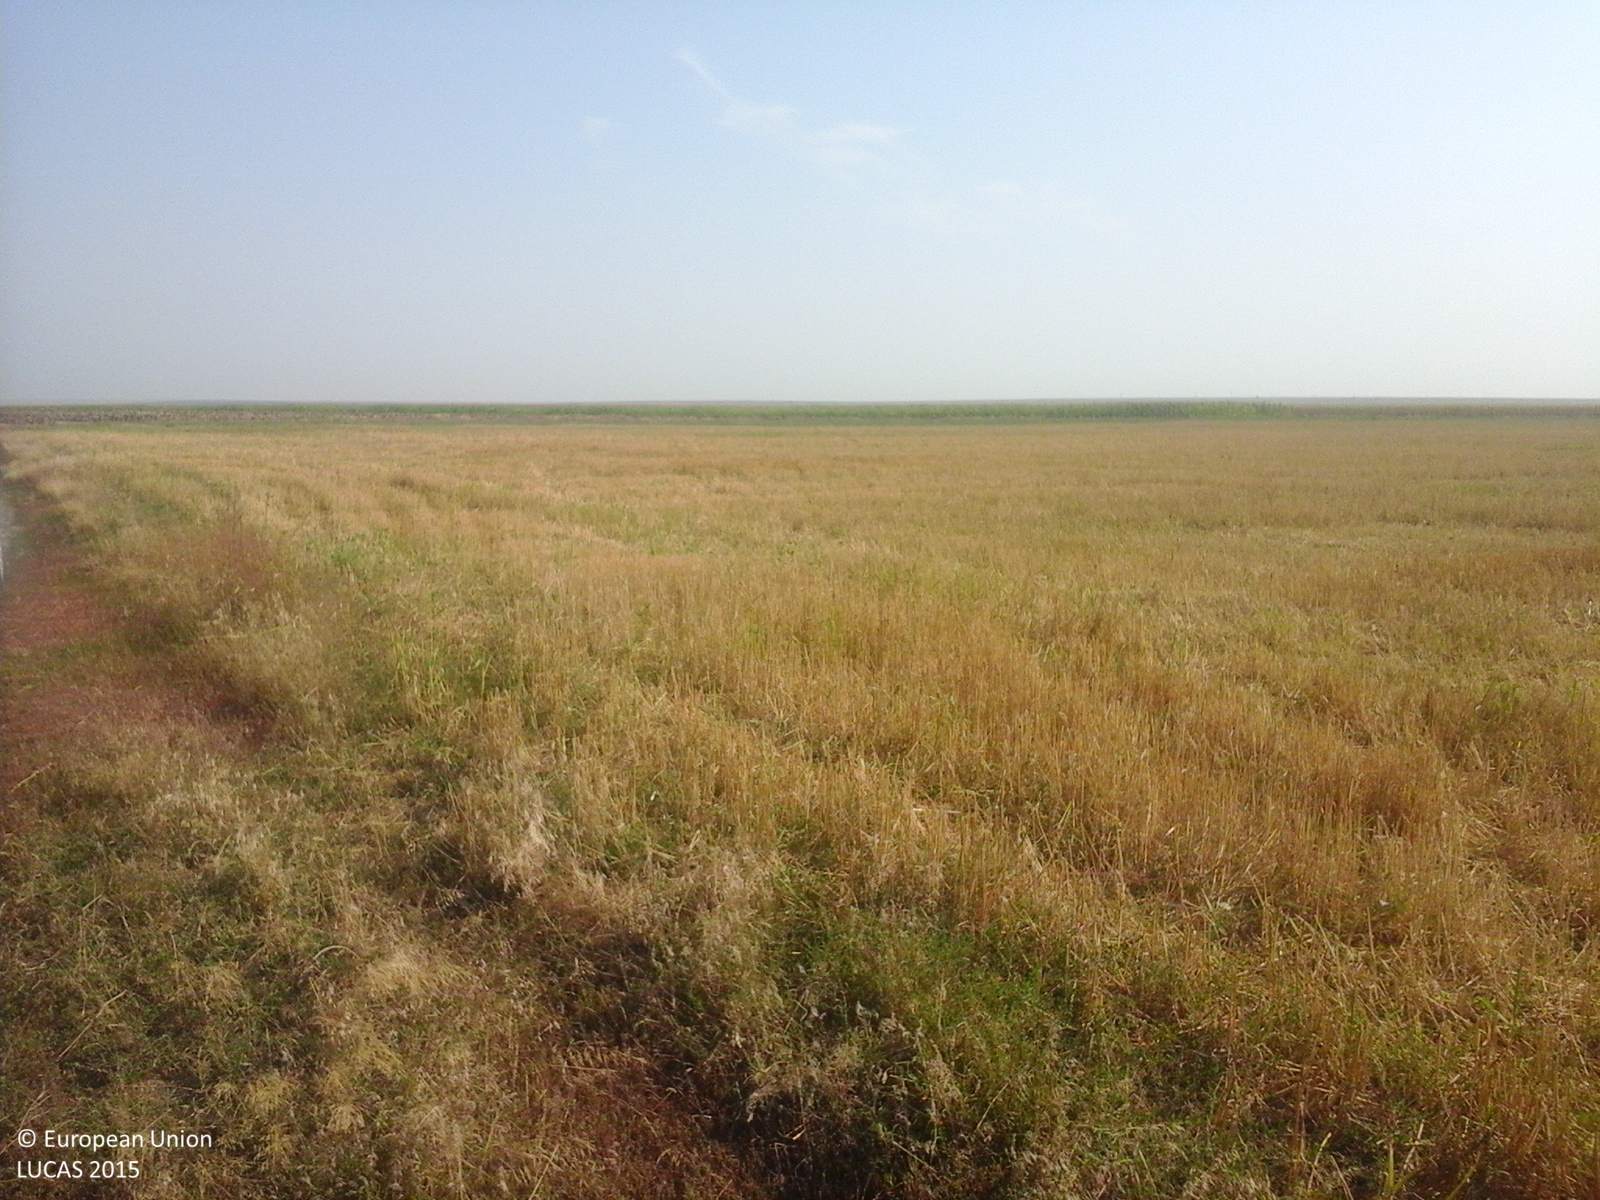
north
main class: Cropland
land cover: Common wheat
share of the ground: > 75 %
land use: Agriculture (excluding fallow land and kitchen gardens)
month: August
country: RO
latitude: 45.7119
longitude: 27.5637
